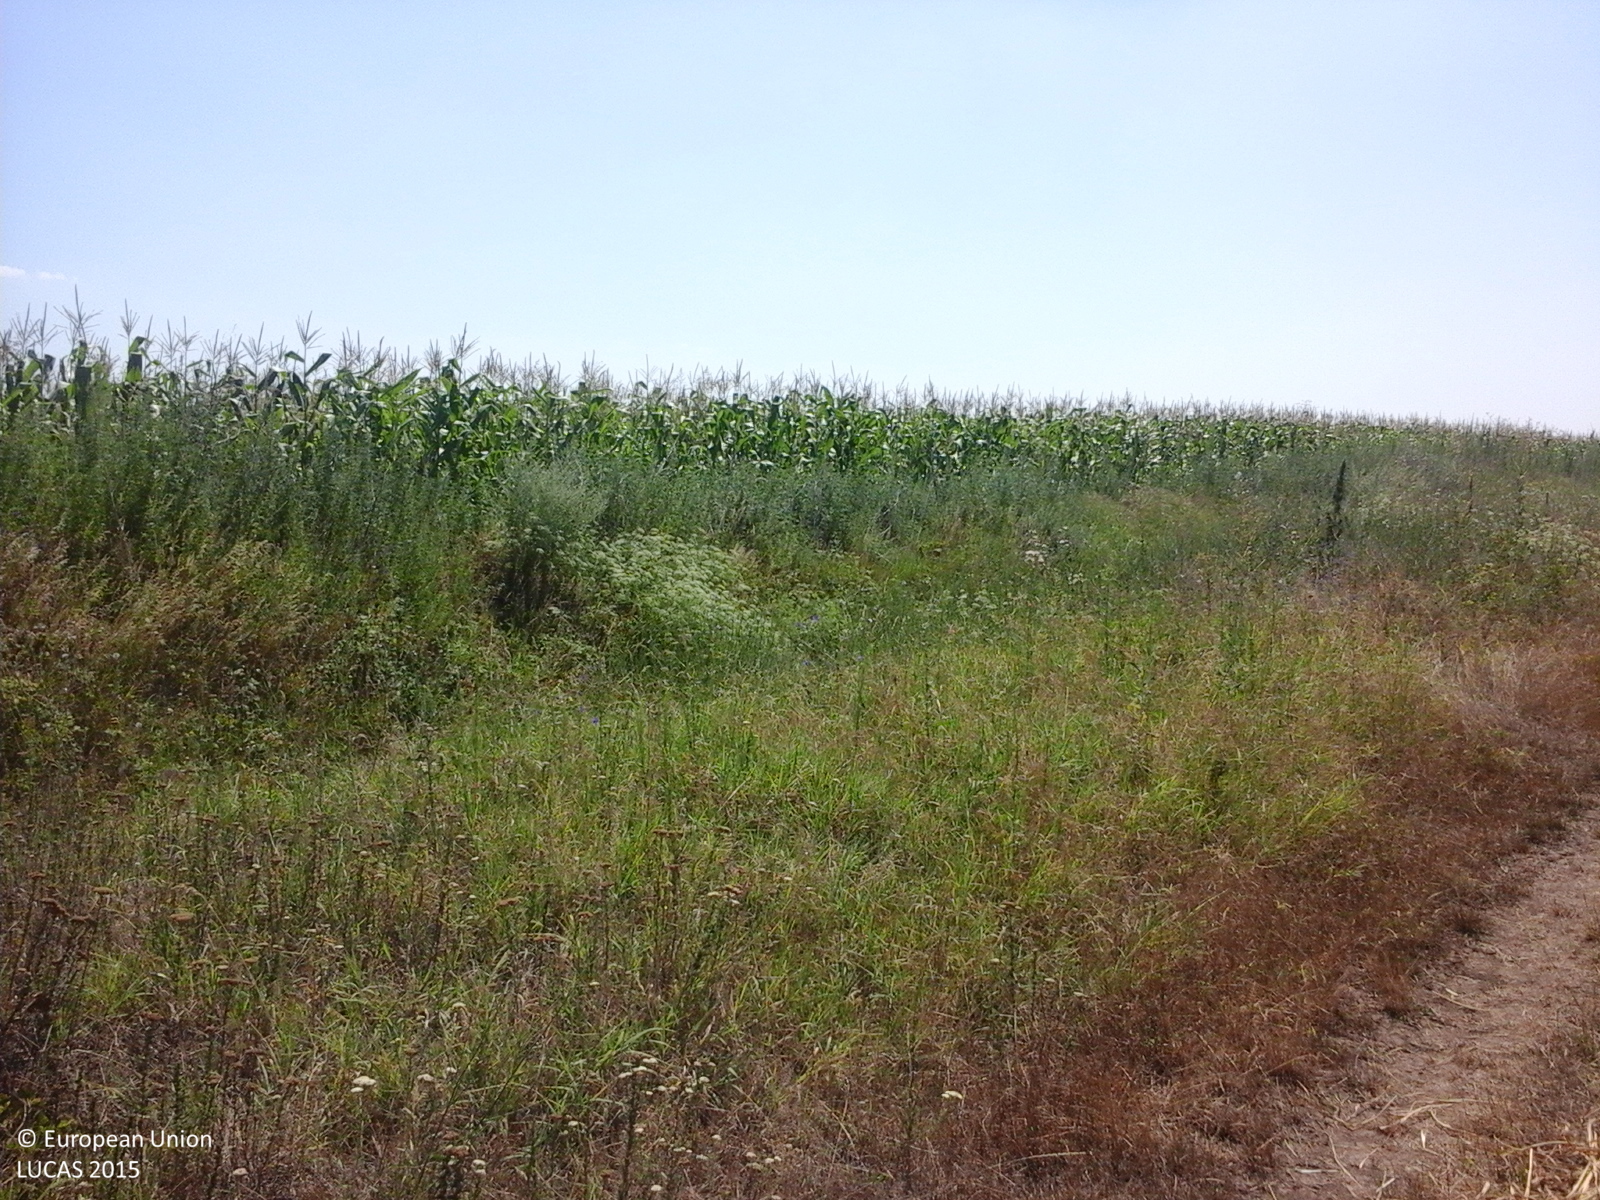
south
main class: Cropland
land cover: Maize
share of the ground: > 75 %
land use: Agriculture (excluding fallow land and kitchen gardens)
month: July
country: RO
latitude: 44.2738
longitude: 27.0283
